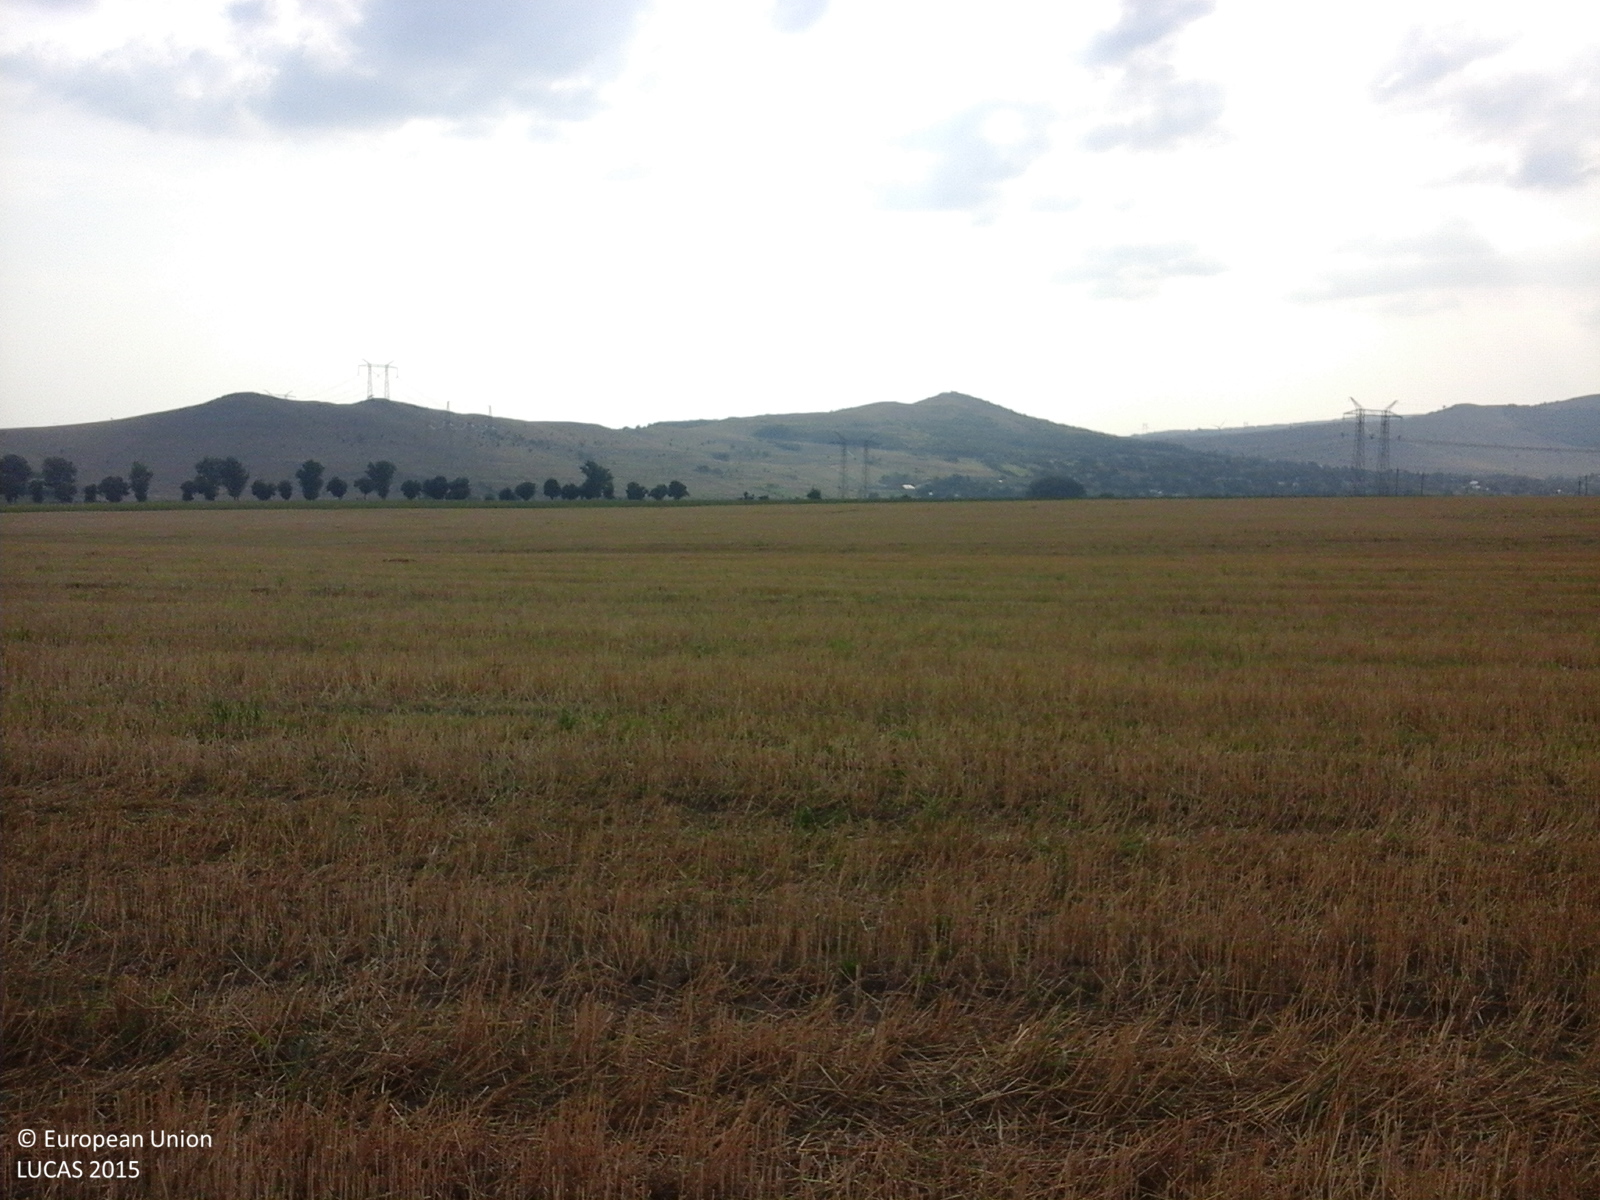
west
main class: Cropland
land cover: Common wheat
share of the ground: > 75 %
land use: Agriculture (excluding fallow land and kitchen gardens)
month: July
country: RO
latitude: 45.0642
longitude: 28.4279
